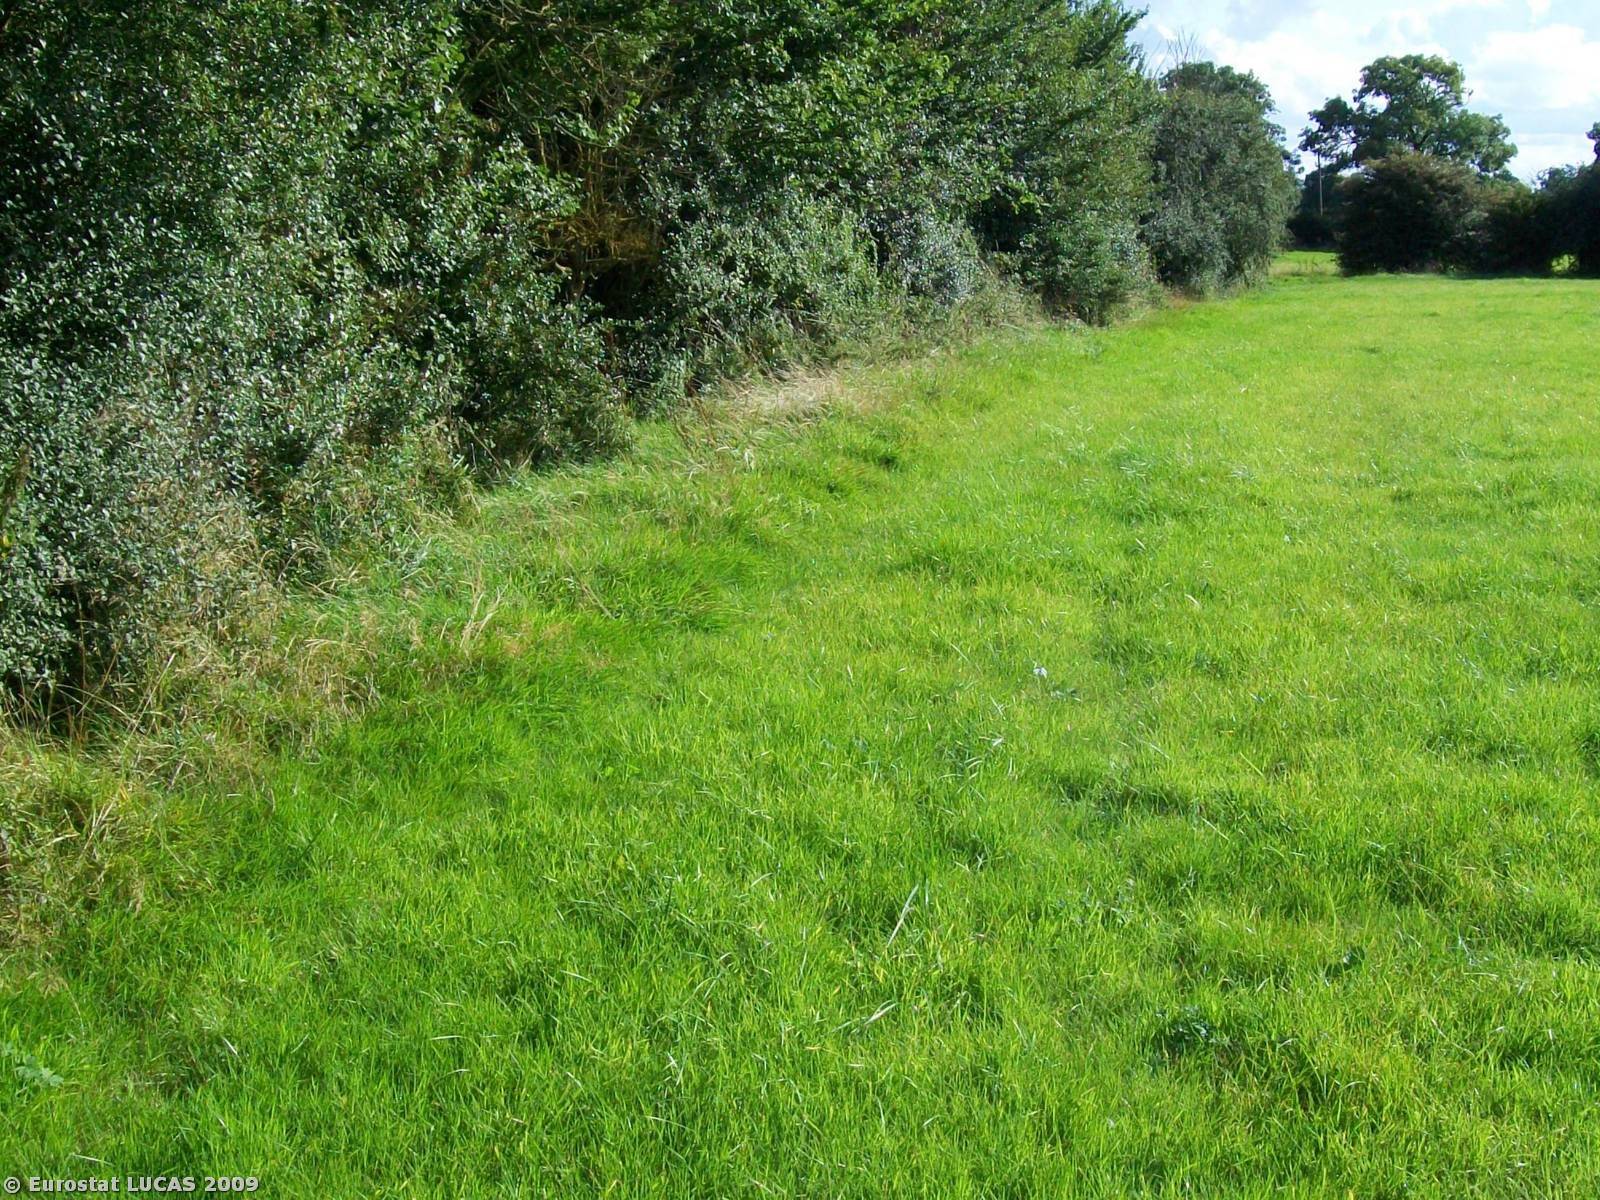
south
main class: Grassland
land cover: Grassland without tree/shrub cover
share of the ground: > 75 %
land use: Agriculture (excluding fallow land and kitchen gardens)
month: August
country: GB
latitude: 52.4722
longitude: -1.1014
